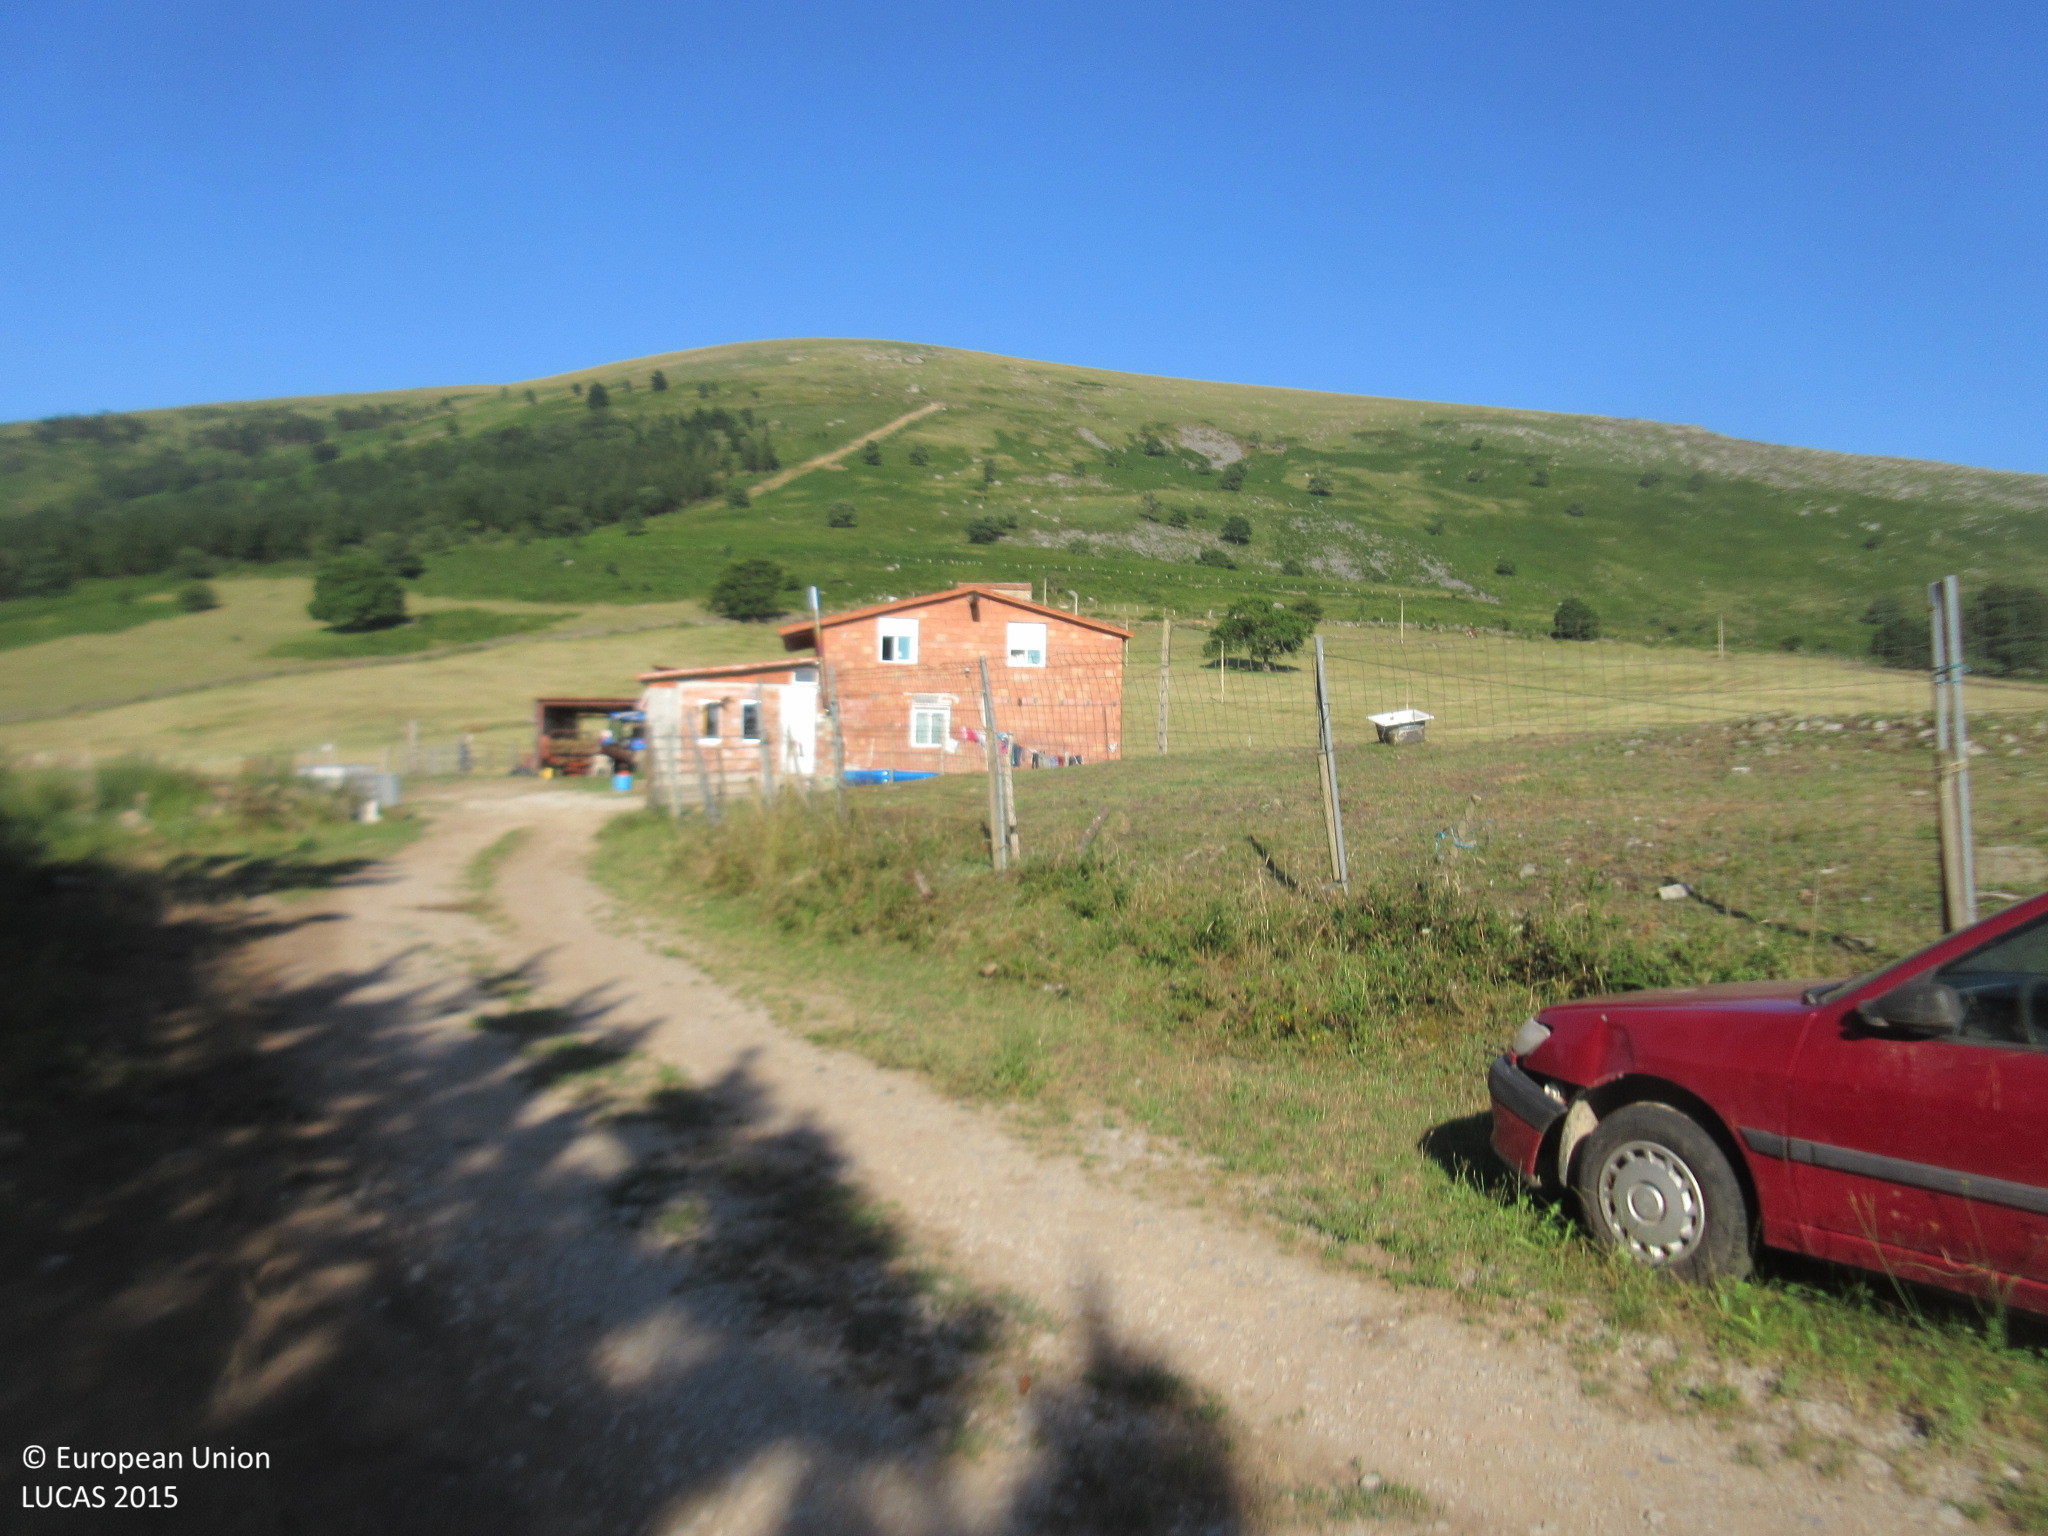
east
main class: Woodland
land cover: Pine dominated coniferous woodland
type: hemiboreal forest and nemoral coniferous forest and mixed broadleaved-coniferous forest
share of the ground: > 75 %
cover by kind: coniferous forest trees 100 %
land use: Forestry
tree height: > 5 m
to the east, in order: Pine dominated coniferous woodland; Grassland without tree/shrub cover; Fences; Grassland without tree/shrub cover
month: July
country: ES
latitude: 43.1916
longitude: -3.8911
